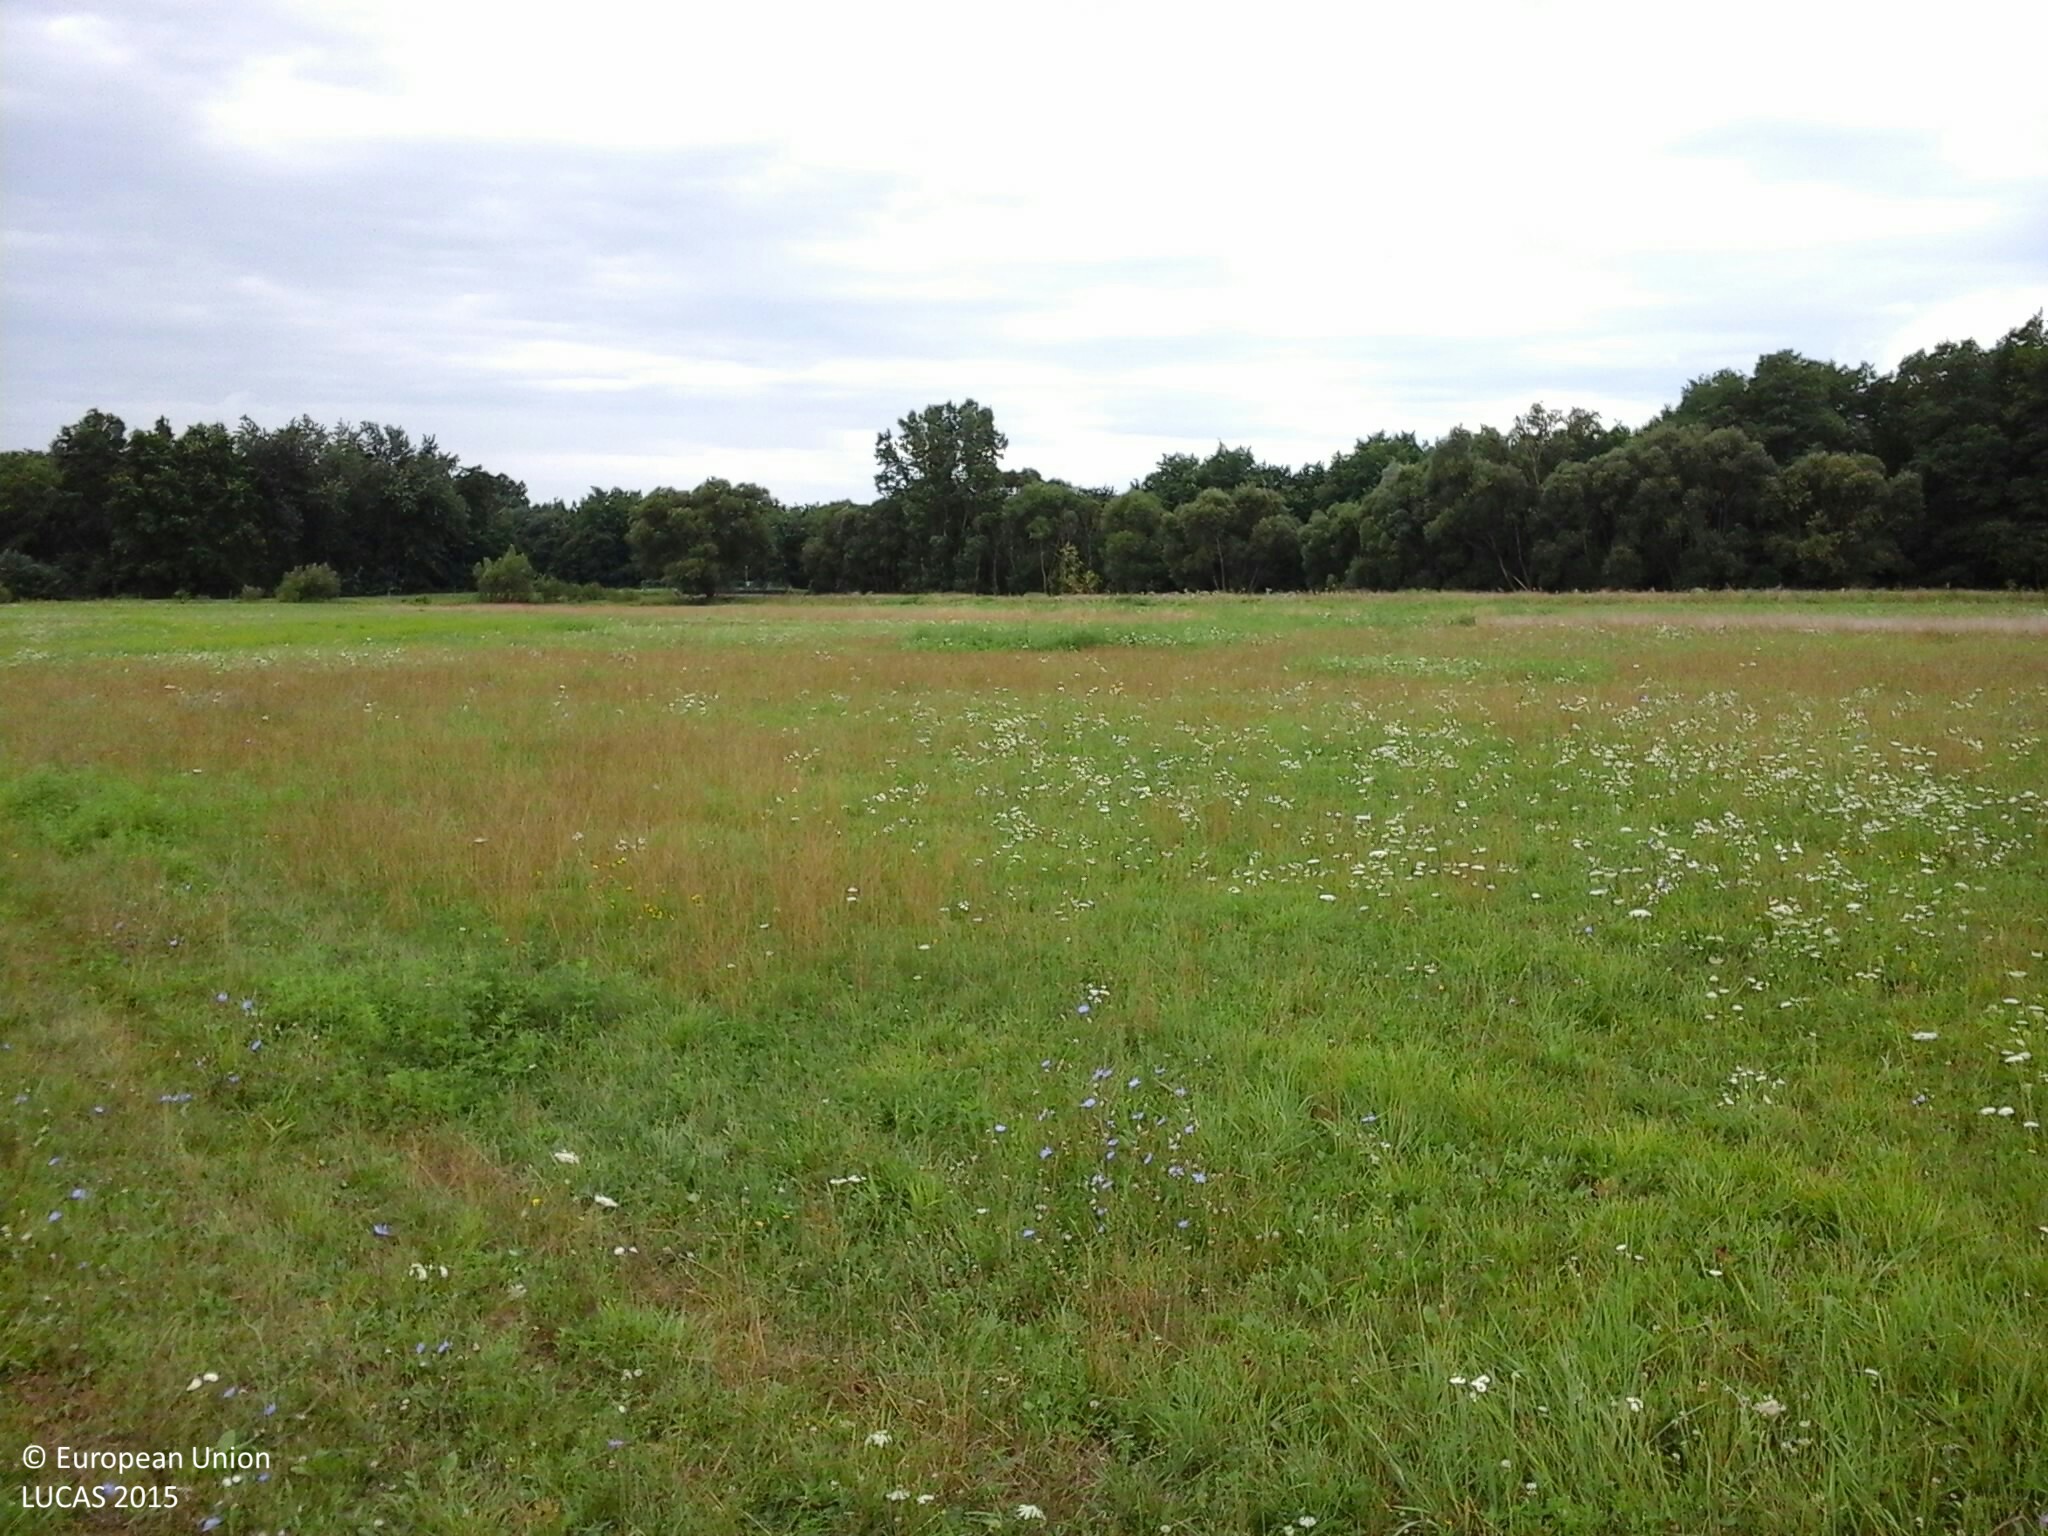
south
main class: Grassland
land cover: Grassland without tree/shrub cover
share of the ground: > 75 %
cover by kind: herbaceous plants 100 %
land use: Agriculture (excluding fallow land and kitchen gardens)
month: July
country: HU
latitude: 46.7507
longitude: 16.4816
